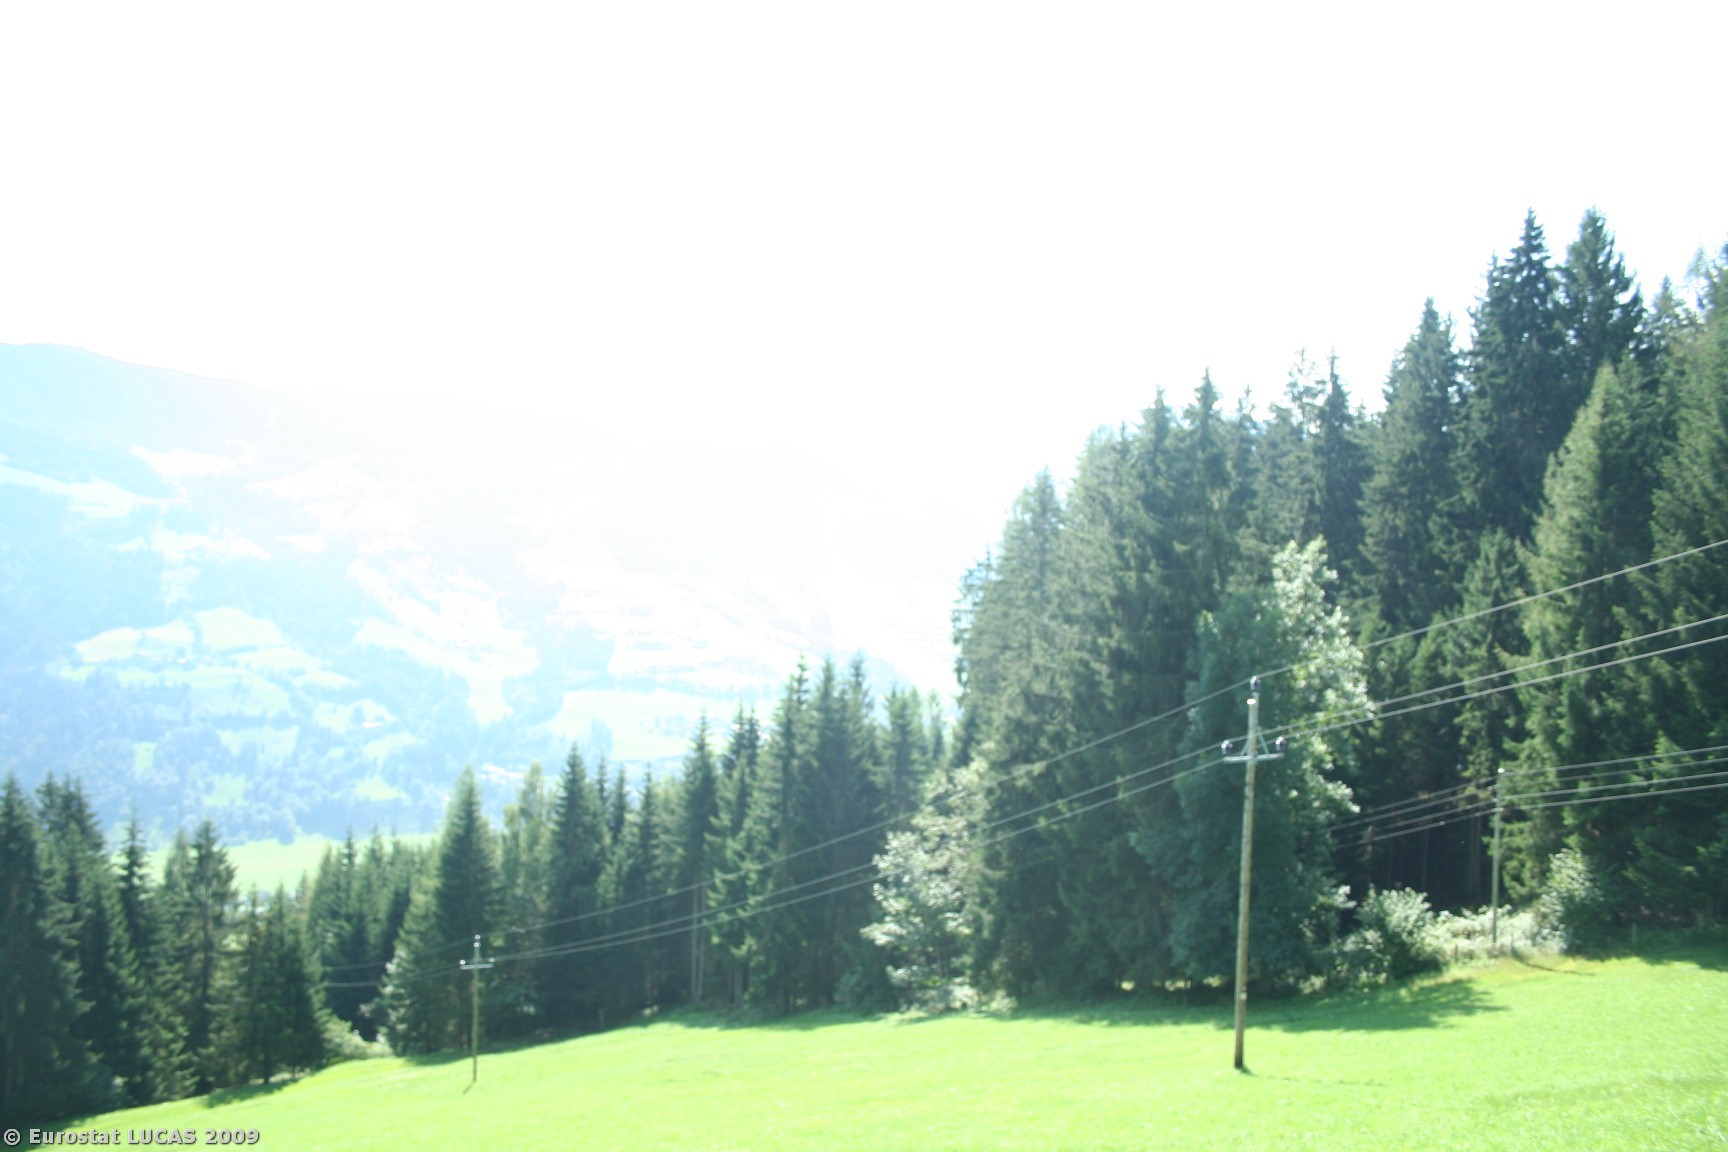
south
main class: Grassland
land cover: Grassland without tree/shrub cover
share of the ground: > 75 %
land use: Agriculture (excluding fallow land and kitchen gardens)
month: August
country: AT
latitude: 47.3669
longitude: 13.1894
